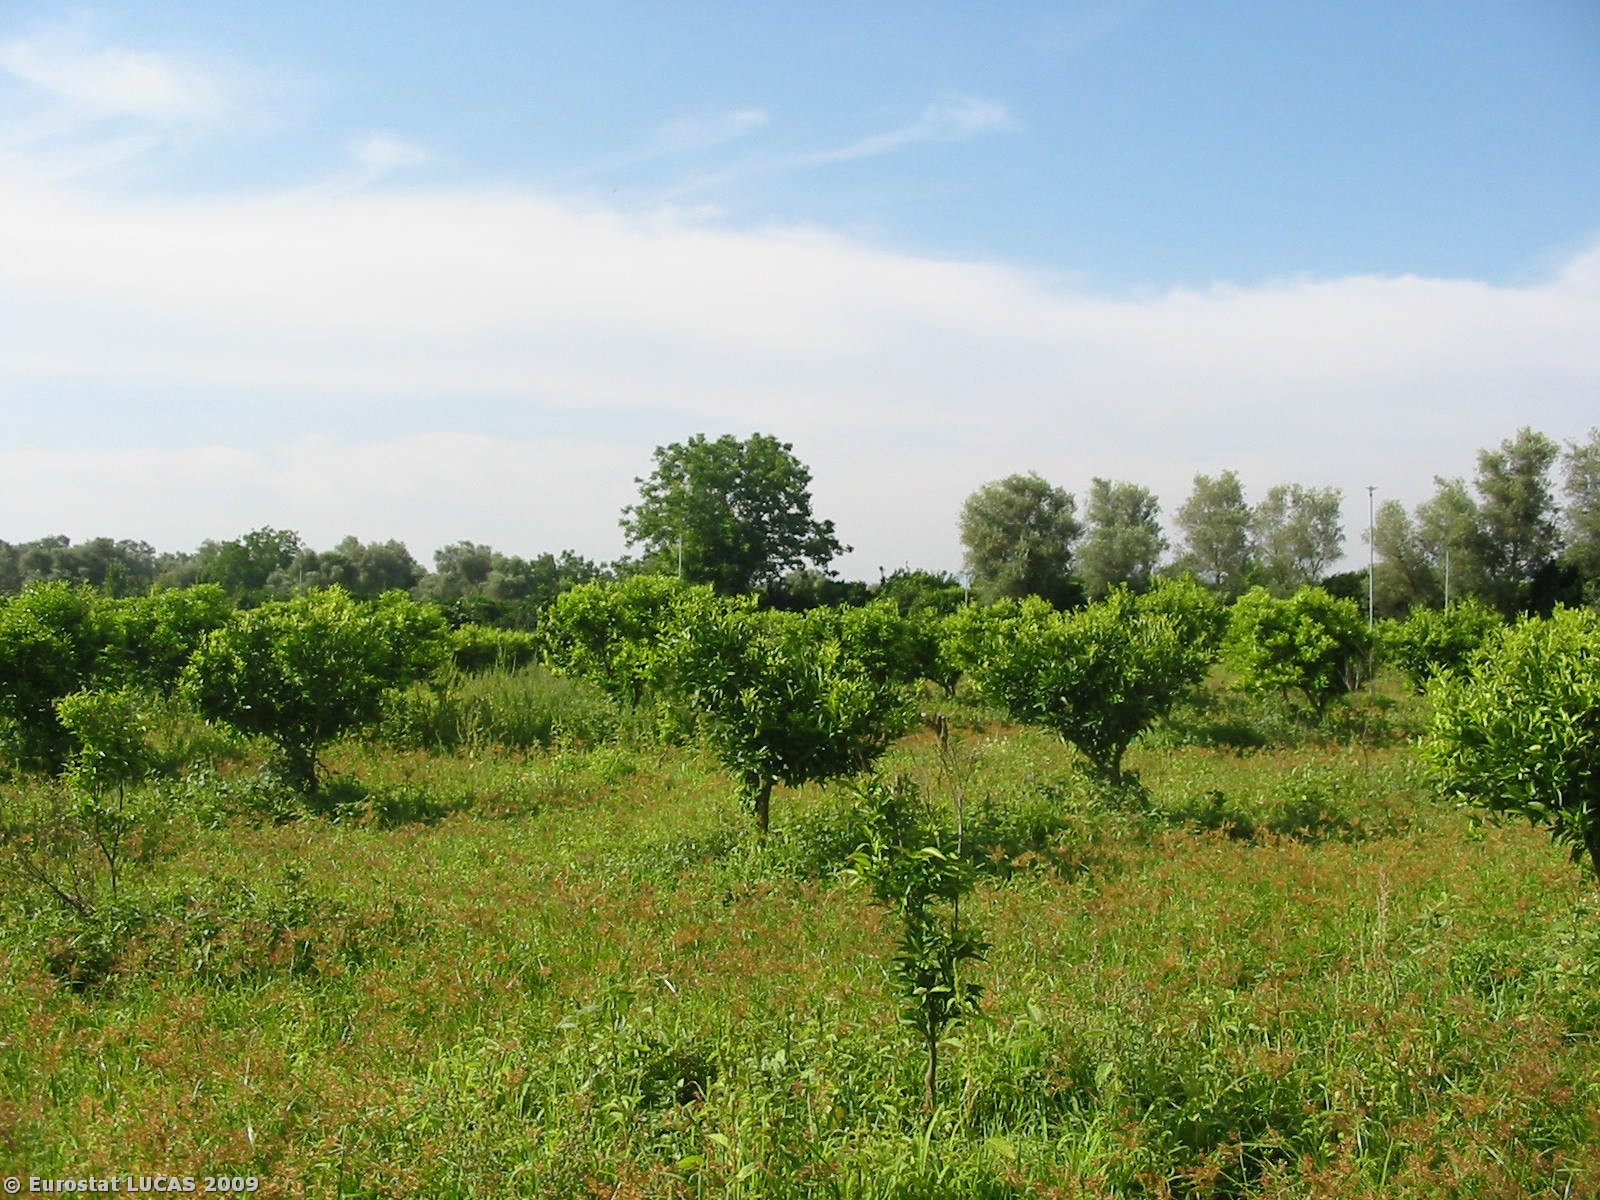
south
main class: Cropland
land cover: Other citrus fruit
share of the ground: 50 - 75 %
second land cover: Spontaneously vegetated surfaces
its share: > 75 %
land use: Agriculture (excluding fallow land and kitchen gardens)
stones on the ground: < 10 %
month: July
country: IT
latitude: 38.4517
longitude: 15.9580
